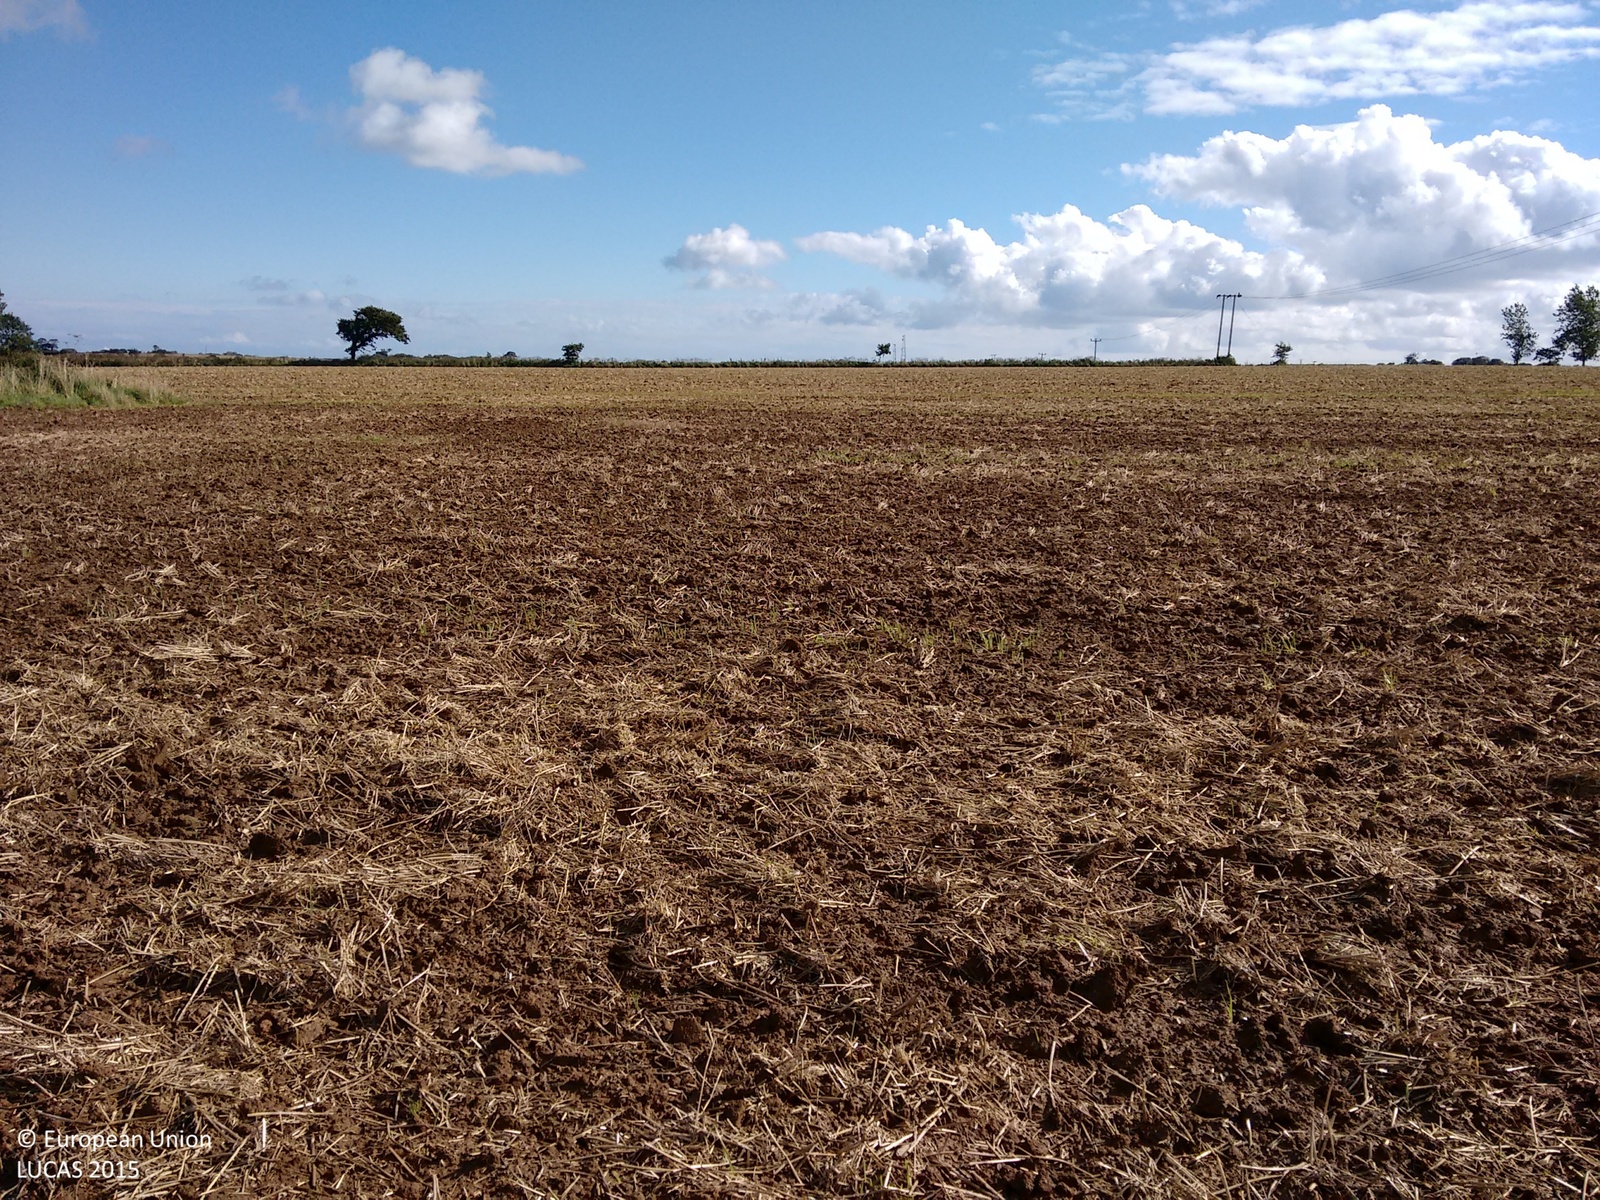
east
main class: Cropland
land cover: Common wheat
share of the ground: > 75 %
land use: Agriculture (excluding fallow land and kitchen gardens)
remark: Harvested field
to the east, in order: Common wheat; Grass margins; Common wheat
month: September
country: GB
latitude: 52.8613
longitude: 1.4103
